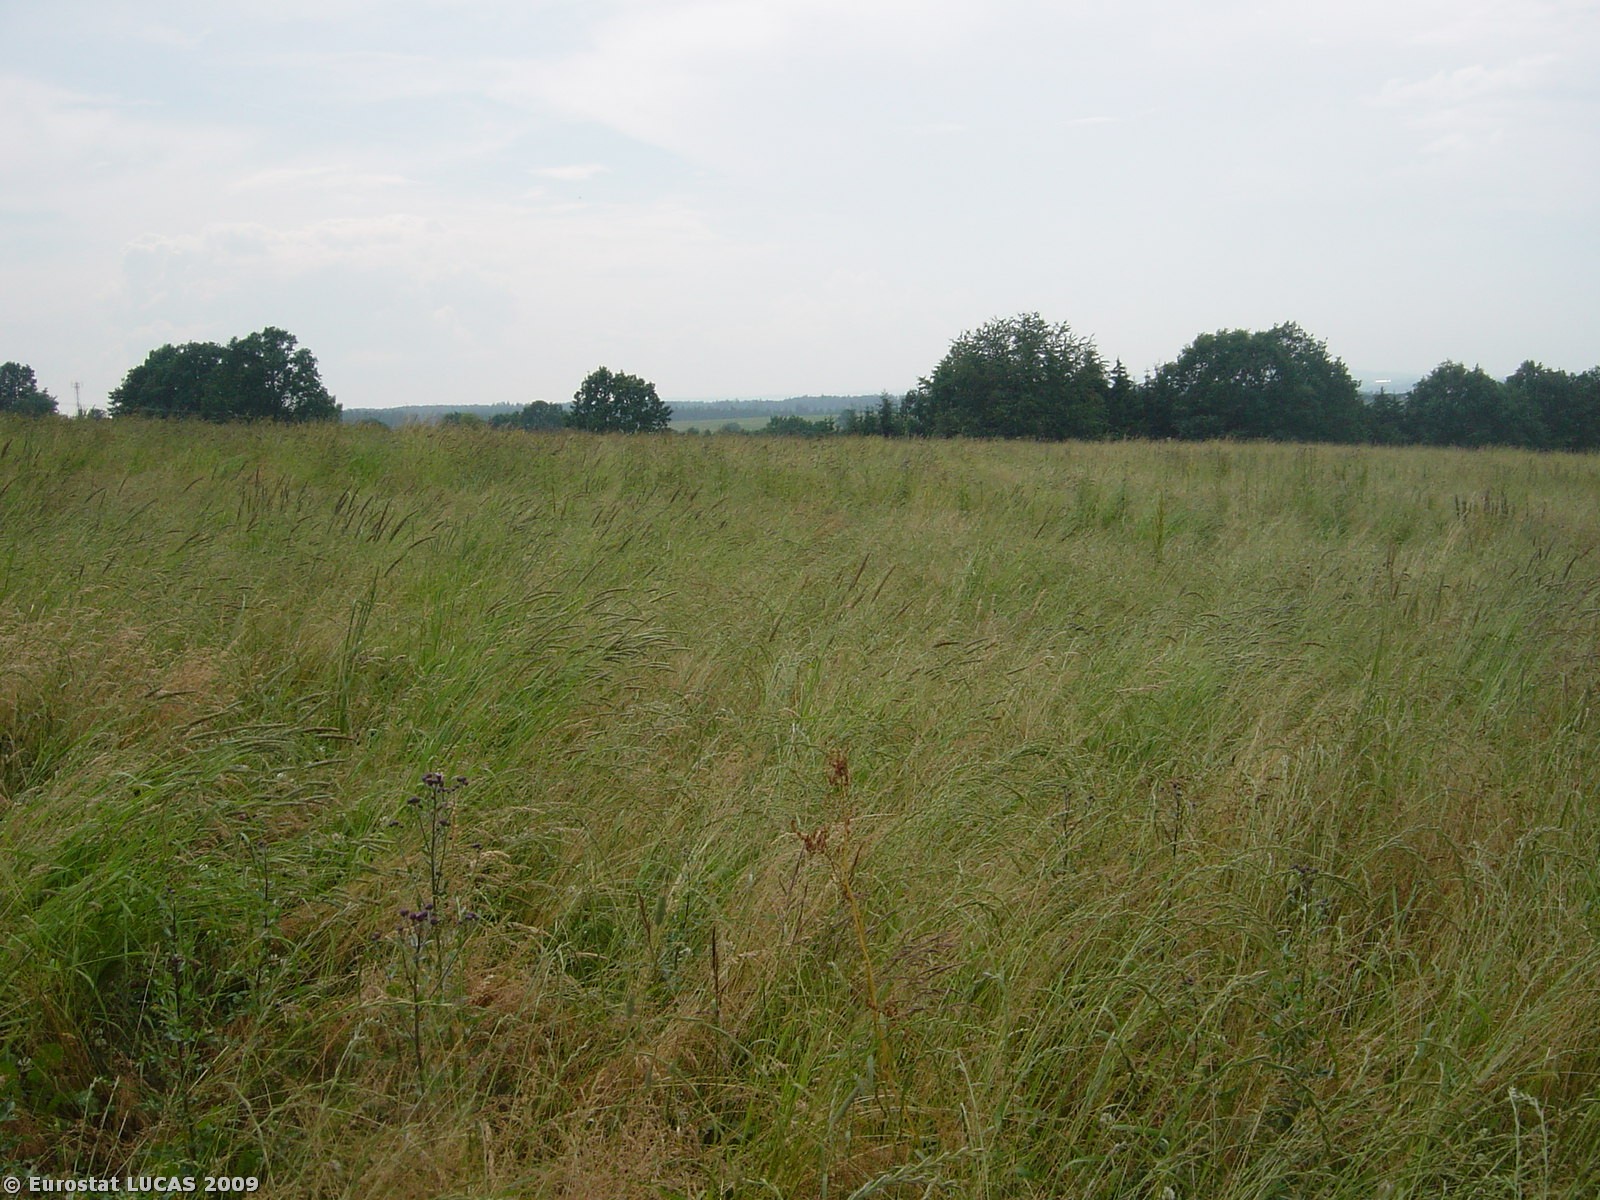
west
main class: Grassland
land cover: Grassland without tree/shrub cover
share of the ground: > 75 %
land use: Agriculture (excluding fallow land and kitchen gardens)
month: July
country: CZ
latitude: 50.0483
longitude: 12.5274
